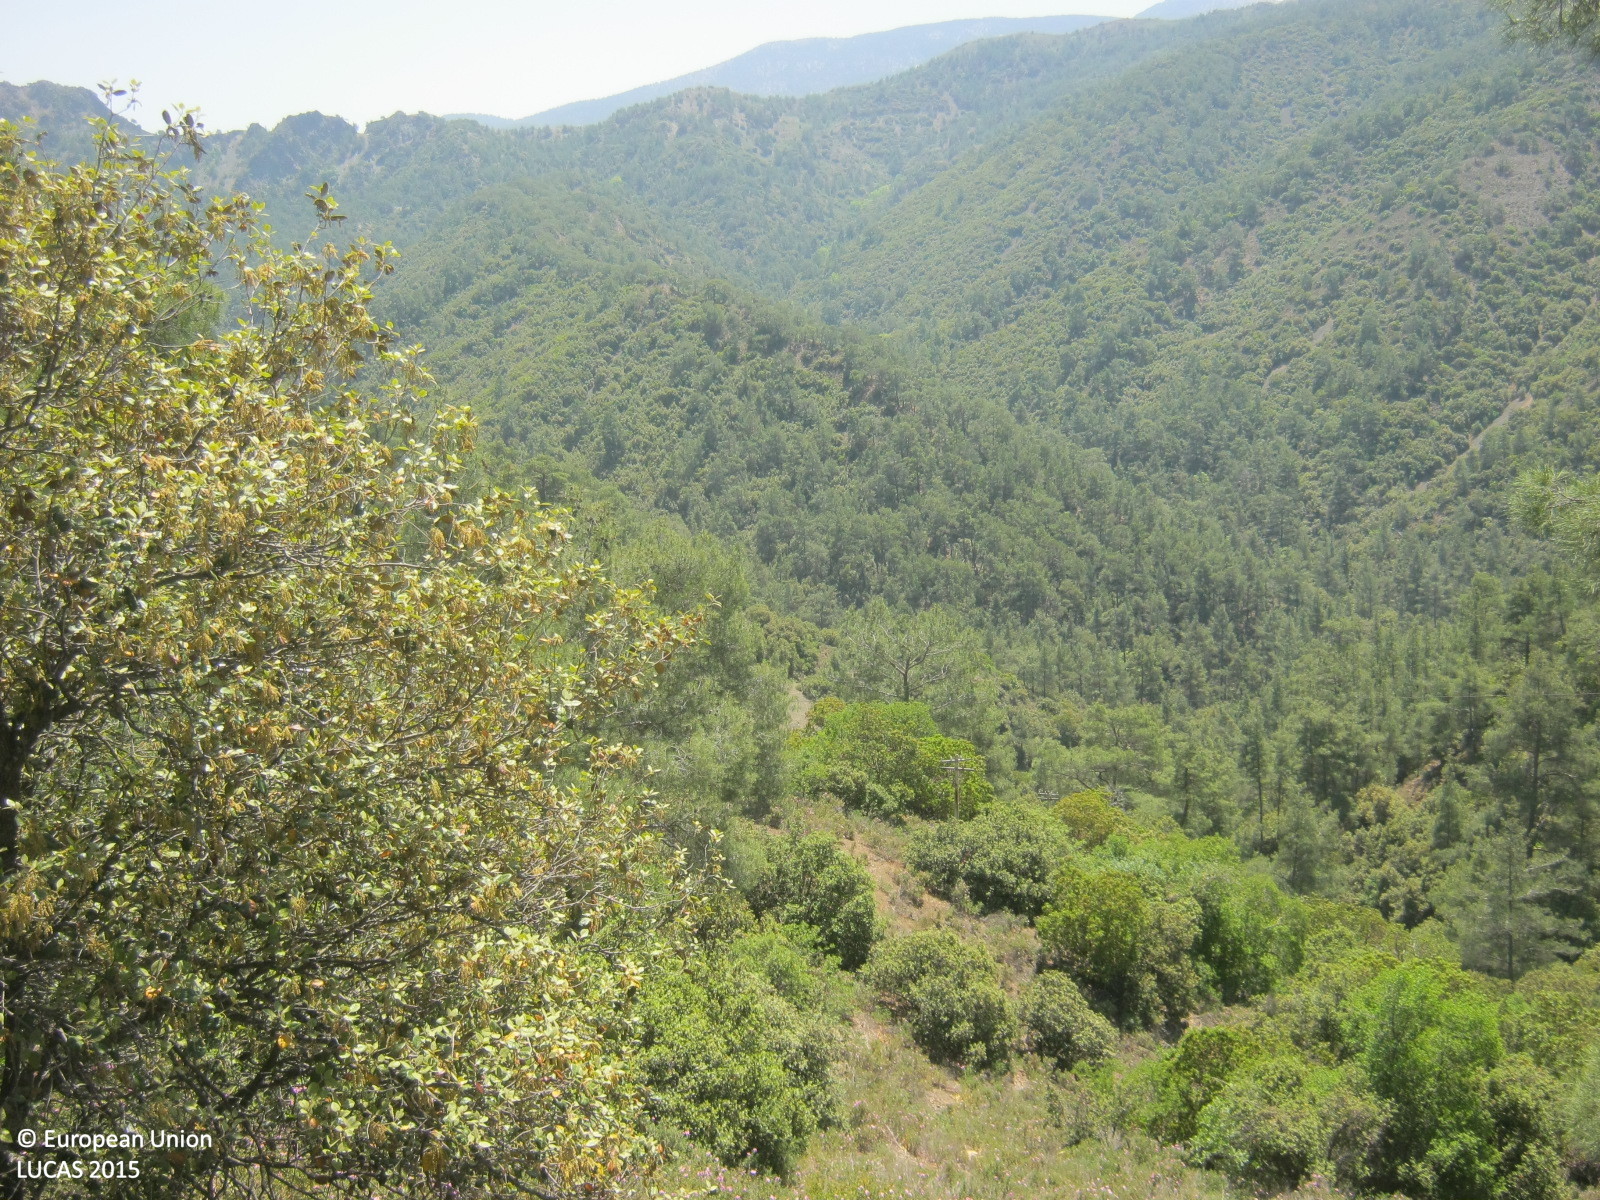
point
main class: Woodland
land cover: Pine dominated mixed woodland
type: coniferous forest of the mediterranean region
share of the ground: > 75 %
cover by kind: coniferous forest trees 75 %, broadleaved forest trees 25 %
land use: Semi-natural and natural areas not in use
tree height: > 5 m
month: May
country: CY
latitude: 34.9799
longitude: 32.7851
